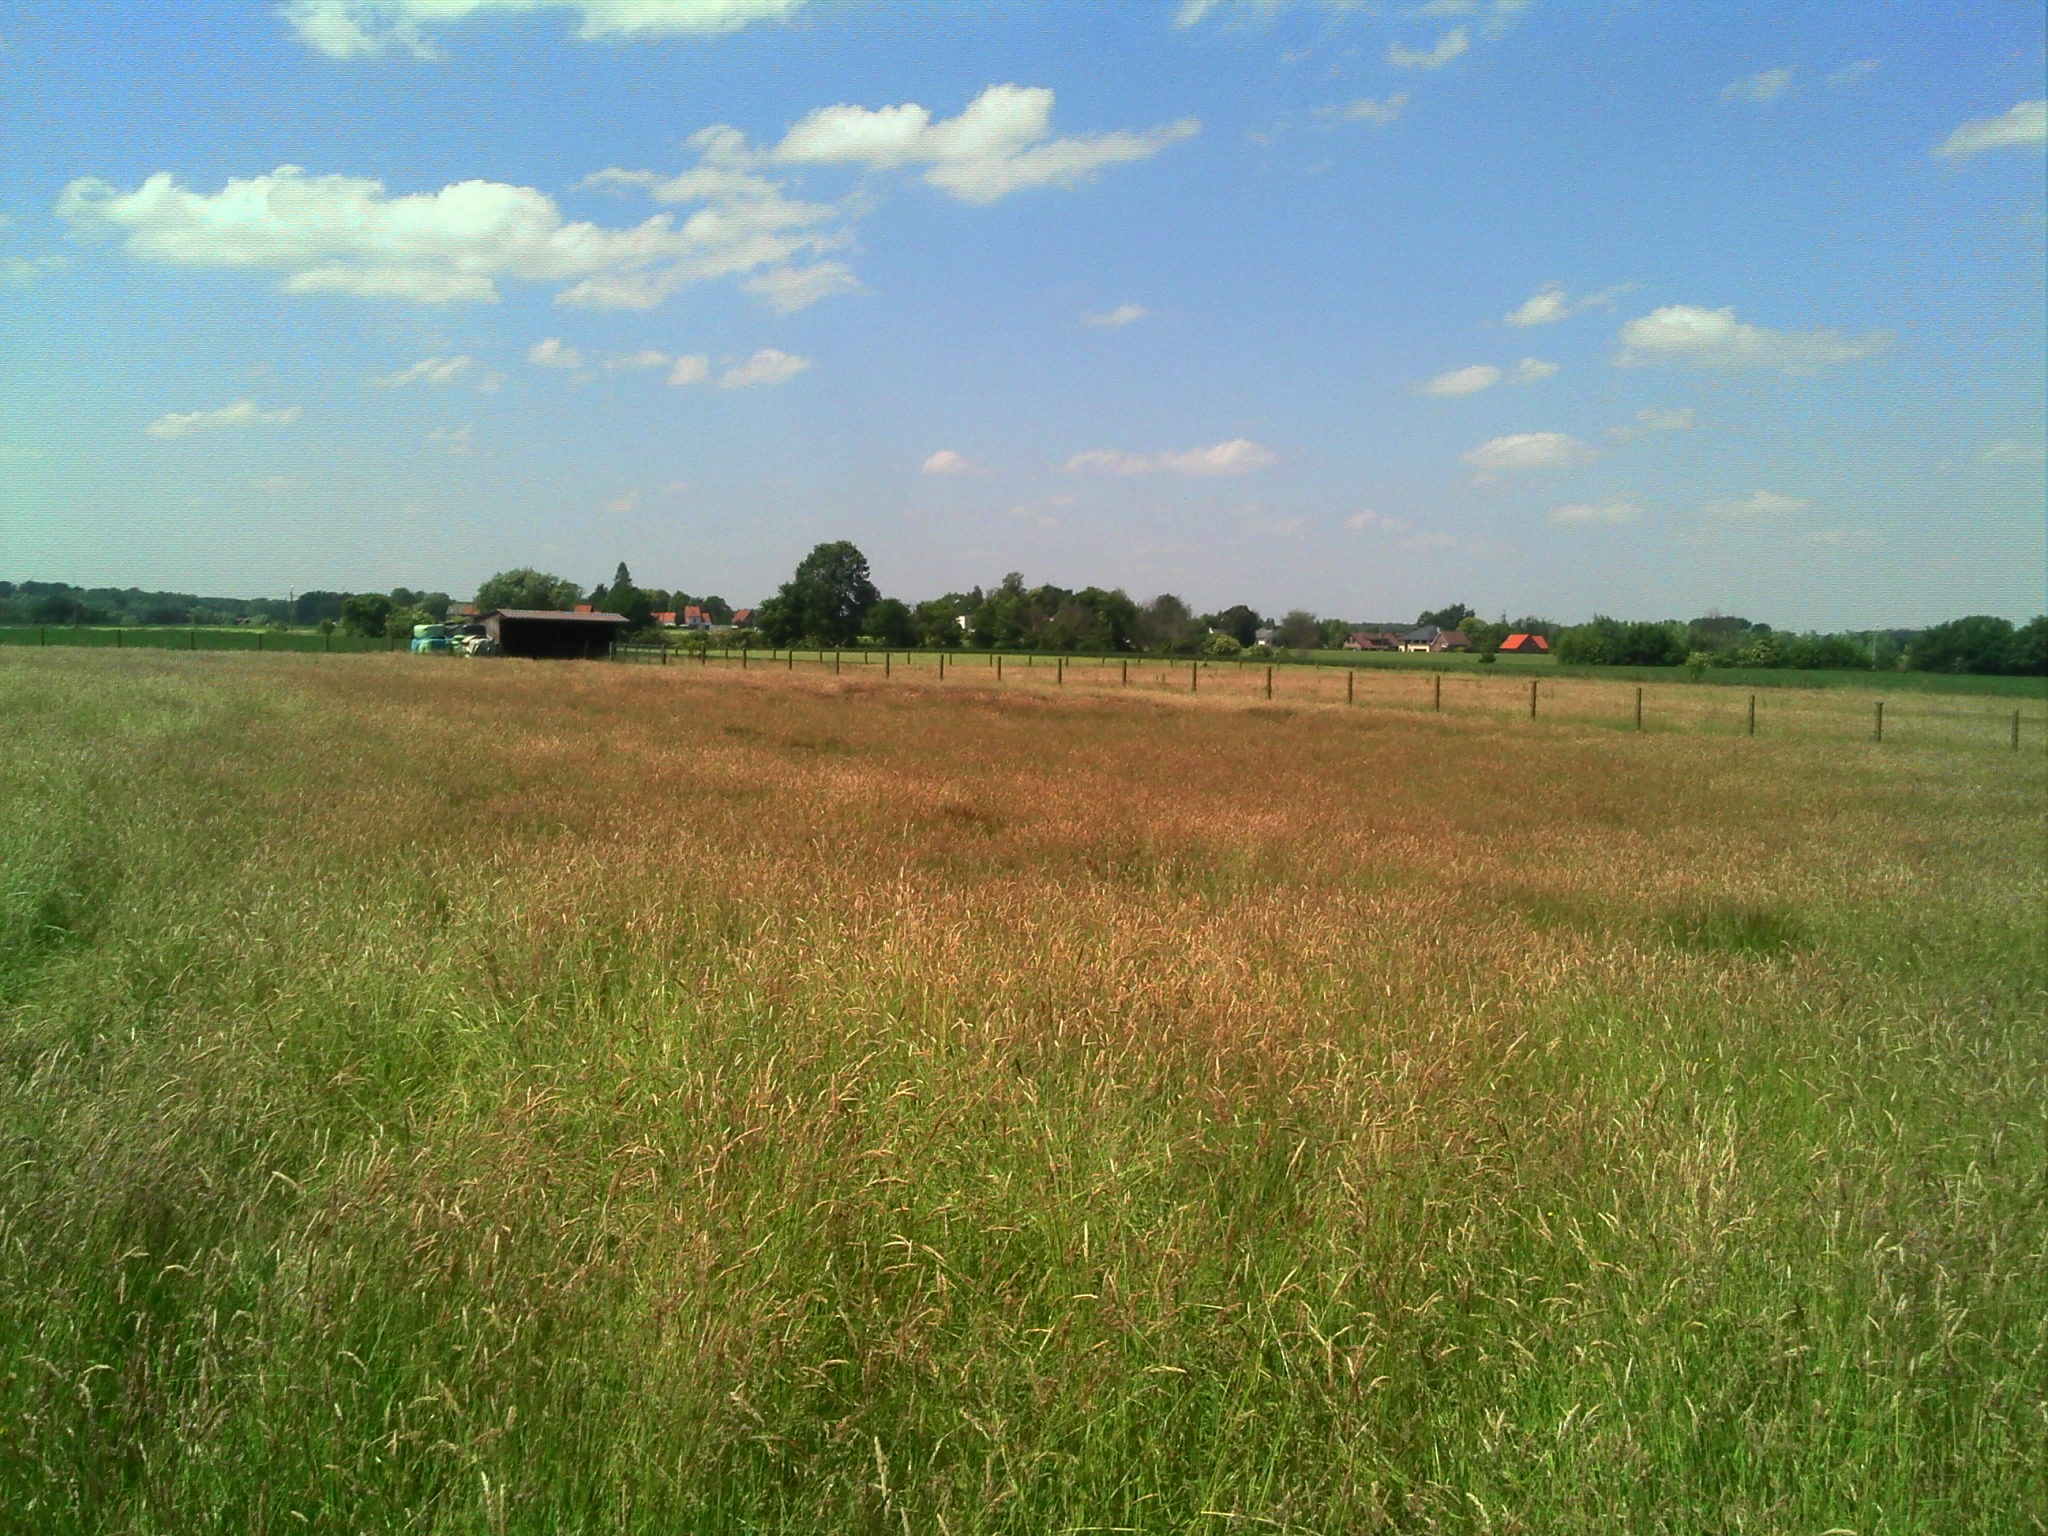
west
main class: Grassland
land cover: Grassland without tree/shrub cover
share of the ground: > 75 %
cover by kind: herbaceous plants 100 %
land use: Agriculture (excluding fallow land and kitchen gardens)
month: June
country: BE
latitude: 50.9438
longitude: 4.3164
